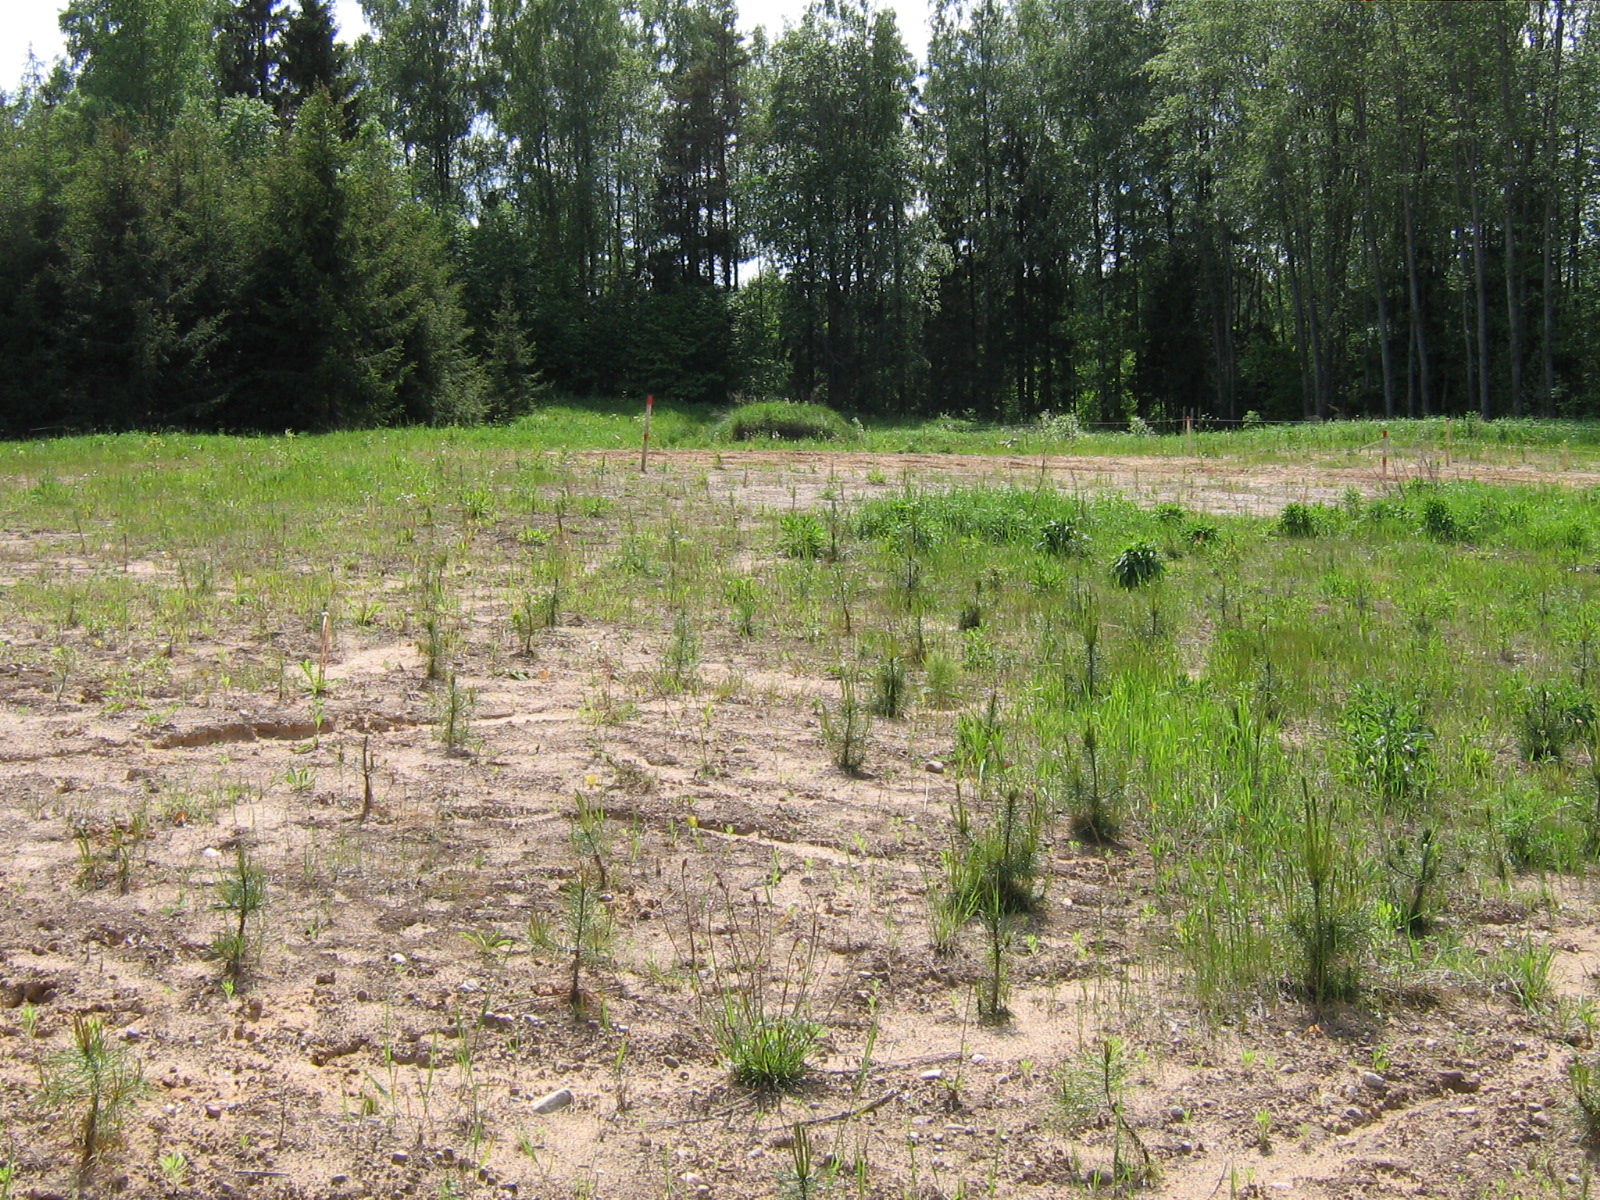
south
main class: Woodland
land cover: Pine dominated coniferous woodland
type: hemiboreal forest and nemoral coniferous forest and mixed broadleaved-coniferous forest
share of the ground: 10 - 25 %
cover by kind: unconsolidated bare surface 60 %, herbaceous plants 25 %, coniferous forest trees 15 %
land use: Forestry
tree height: < 5 m
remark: Nursery
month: June
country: LV
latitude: 57.0429
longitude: 25.2918
